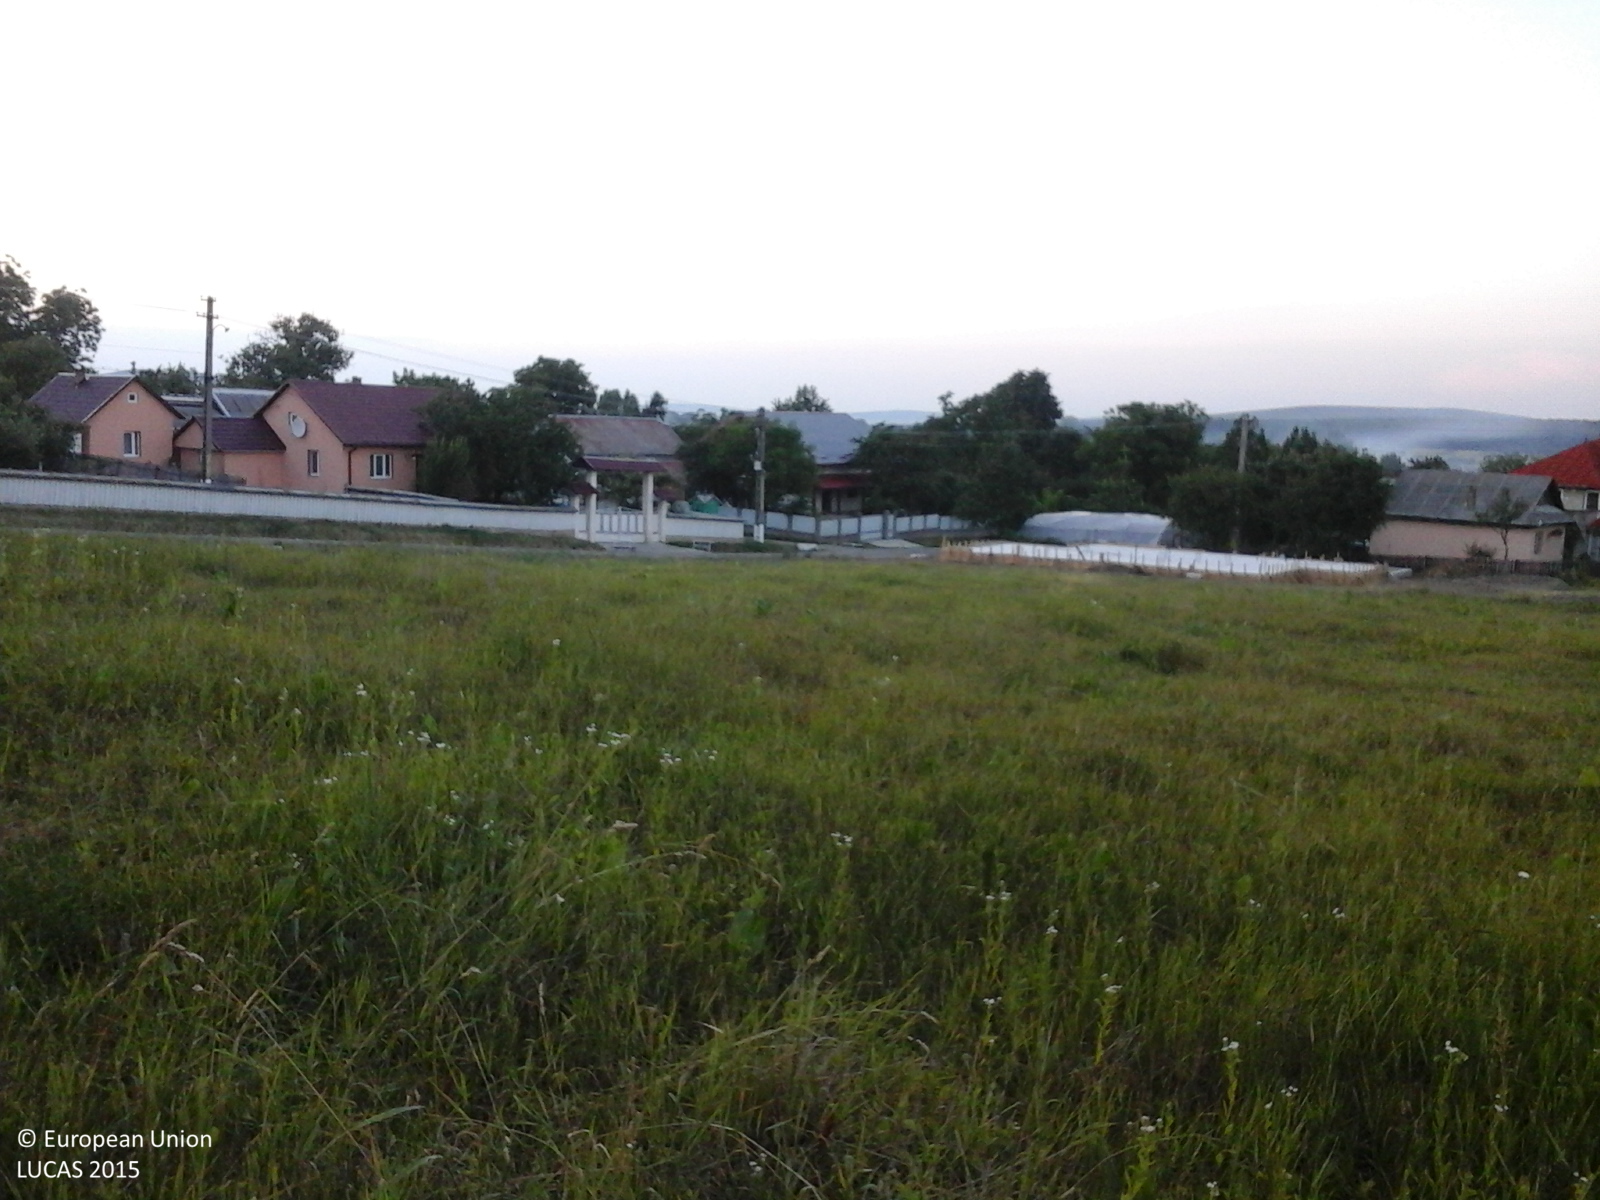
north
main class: Cropland
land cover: Apple fruit
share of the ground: > 75 %
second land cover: Grassland without tree/shrub cover
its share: > 75 %
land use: Kitchen garden
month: June
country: RO
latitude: 47.7358
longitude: 26.2864
